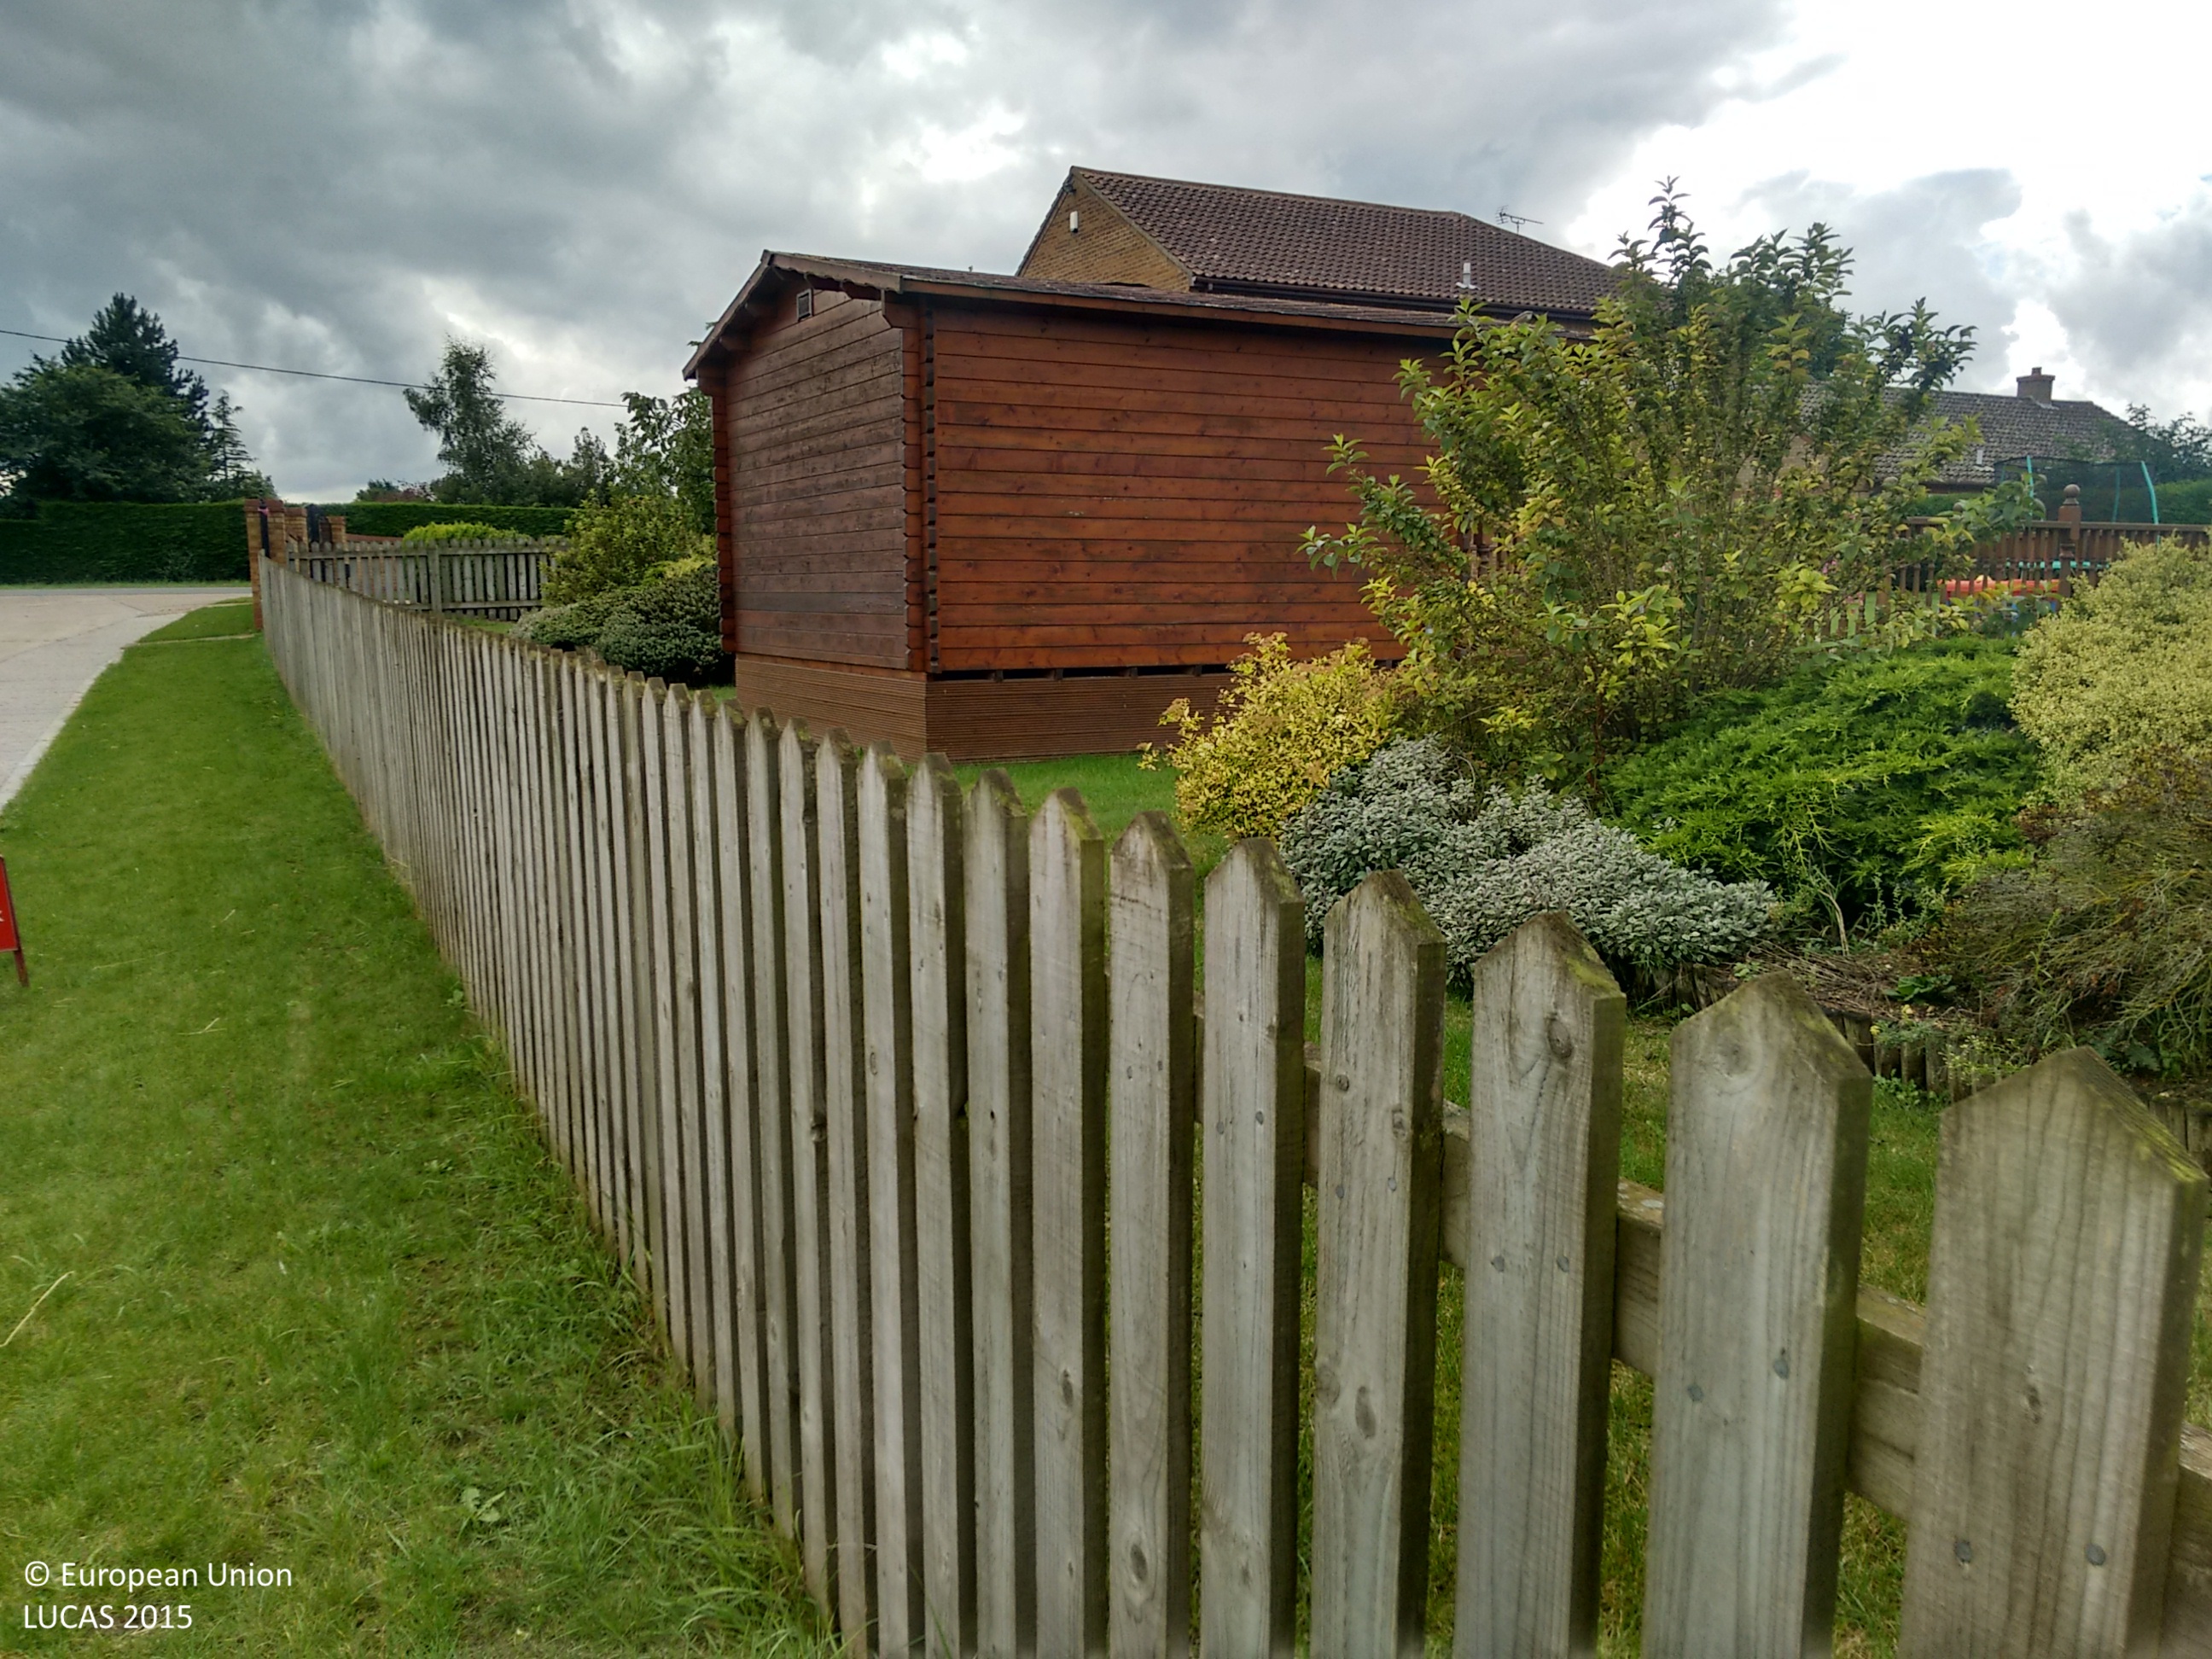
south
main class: Grassland
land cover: Grassland with sparse tree/shrub cover
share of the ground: > 75 %
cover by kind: herbaceous plants 85 %, shrubs 10 %, broadleaved forest trees 5 %
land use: Residential
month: September
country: GB
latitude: 52.3153
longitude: 0.4219
